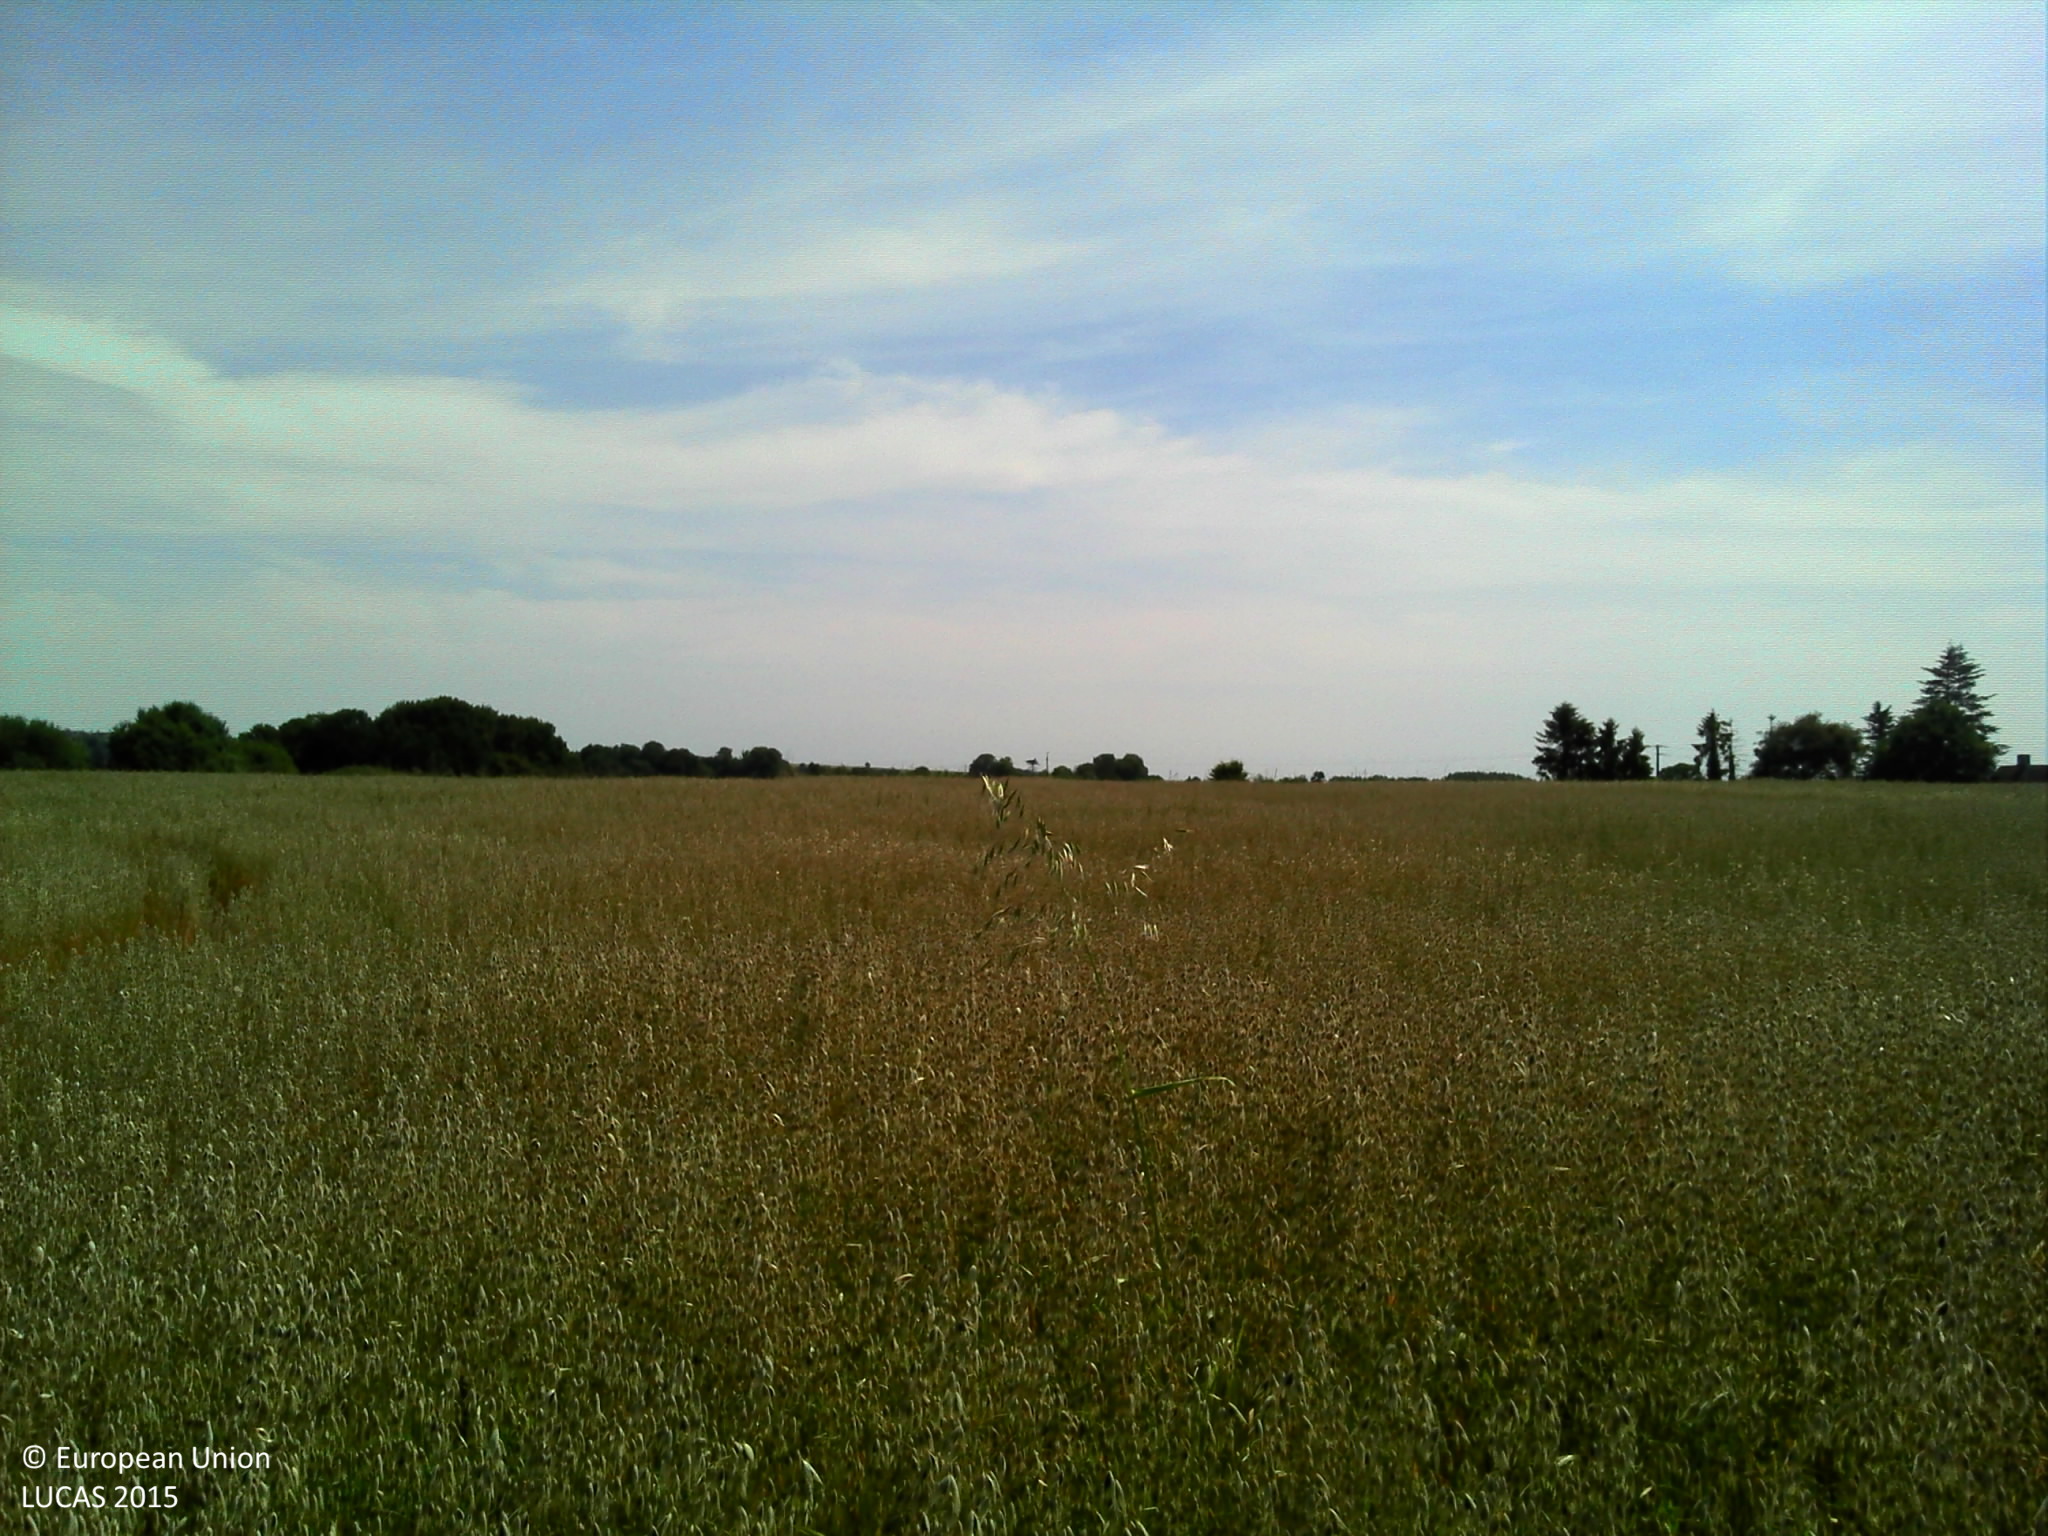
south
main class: Cropland
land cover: Oats
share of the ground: > 75 %
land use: Agriculture (excluding fallow land and kitchen gardens)
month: June
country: FR
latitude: 48.3695
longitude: 0.2403
